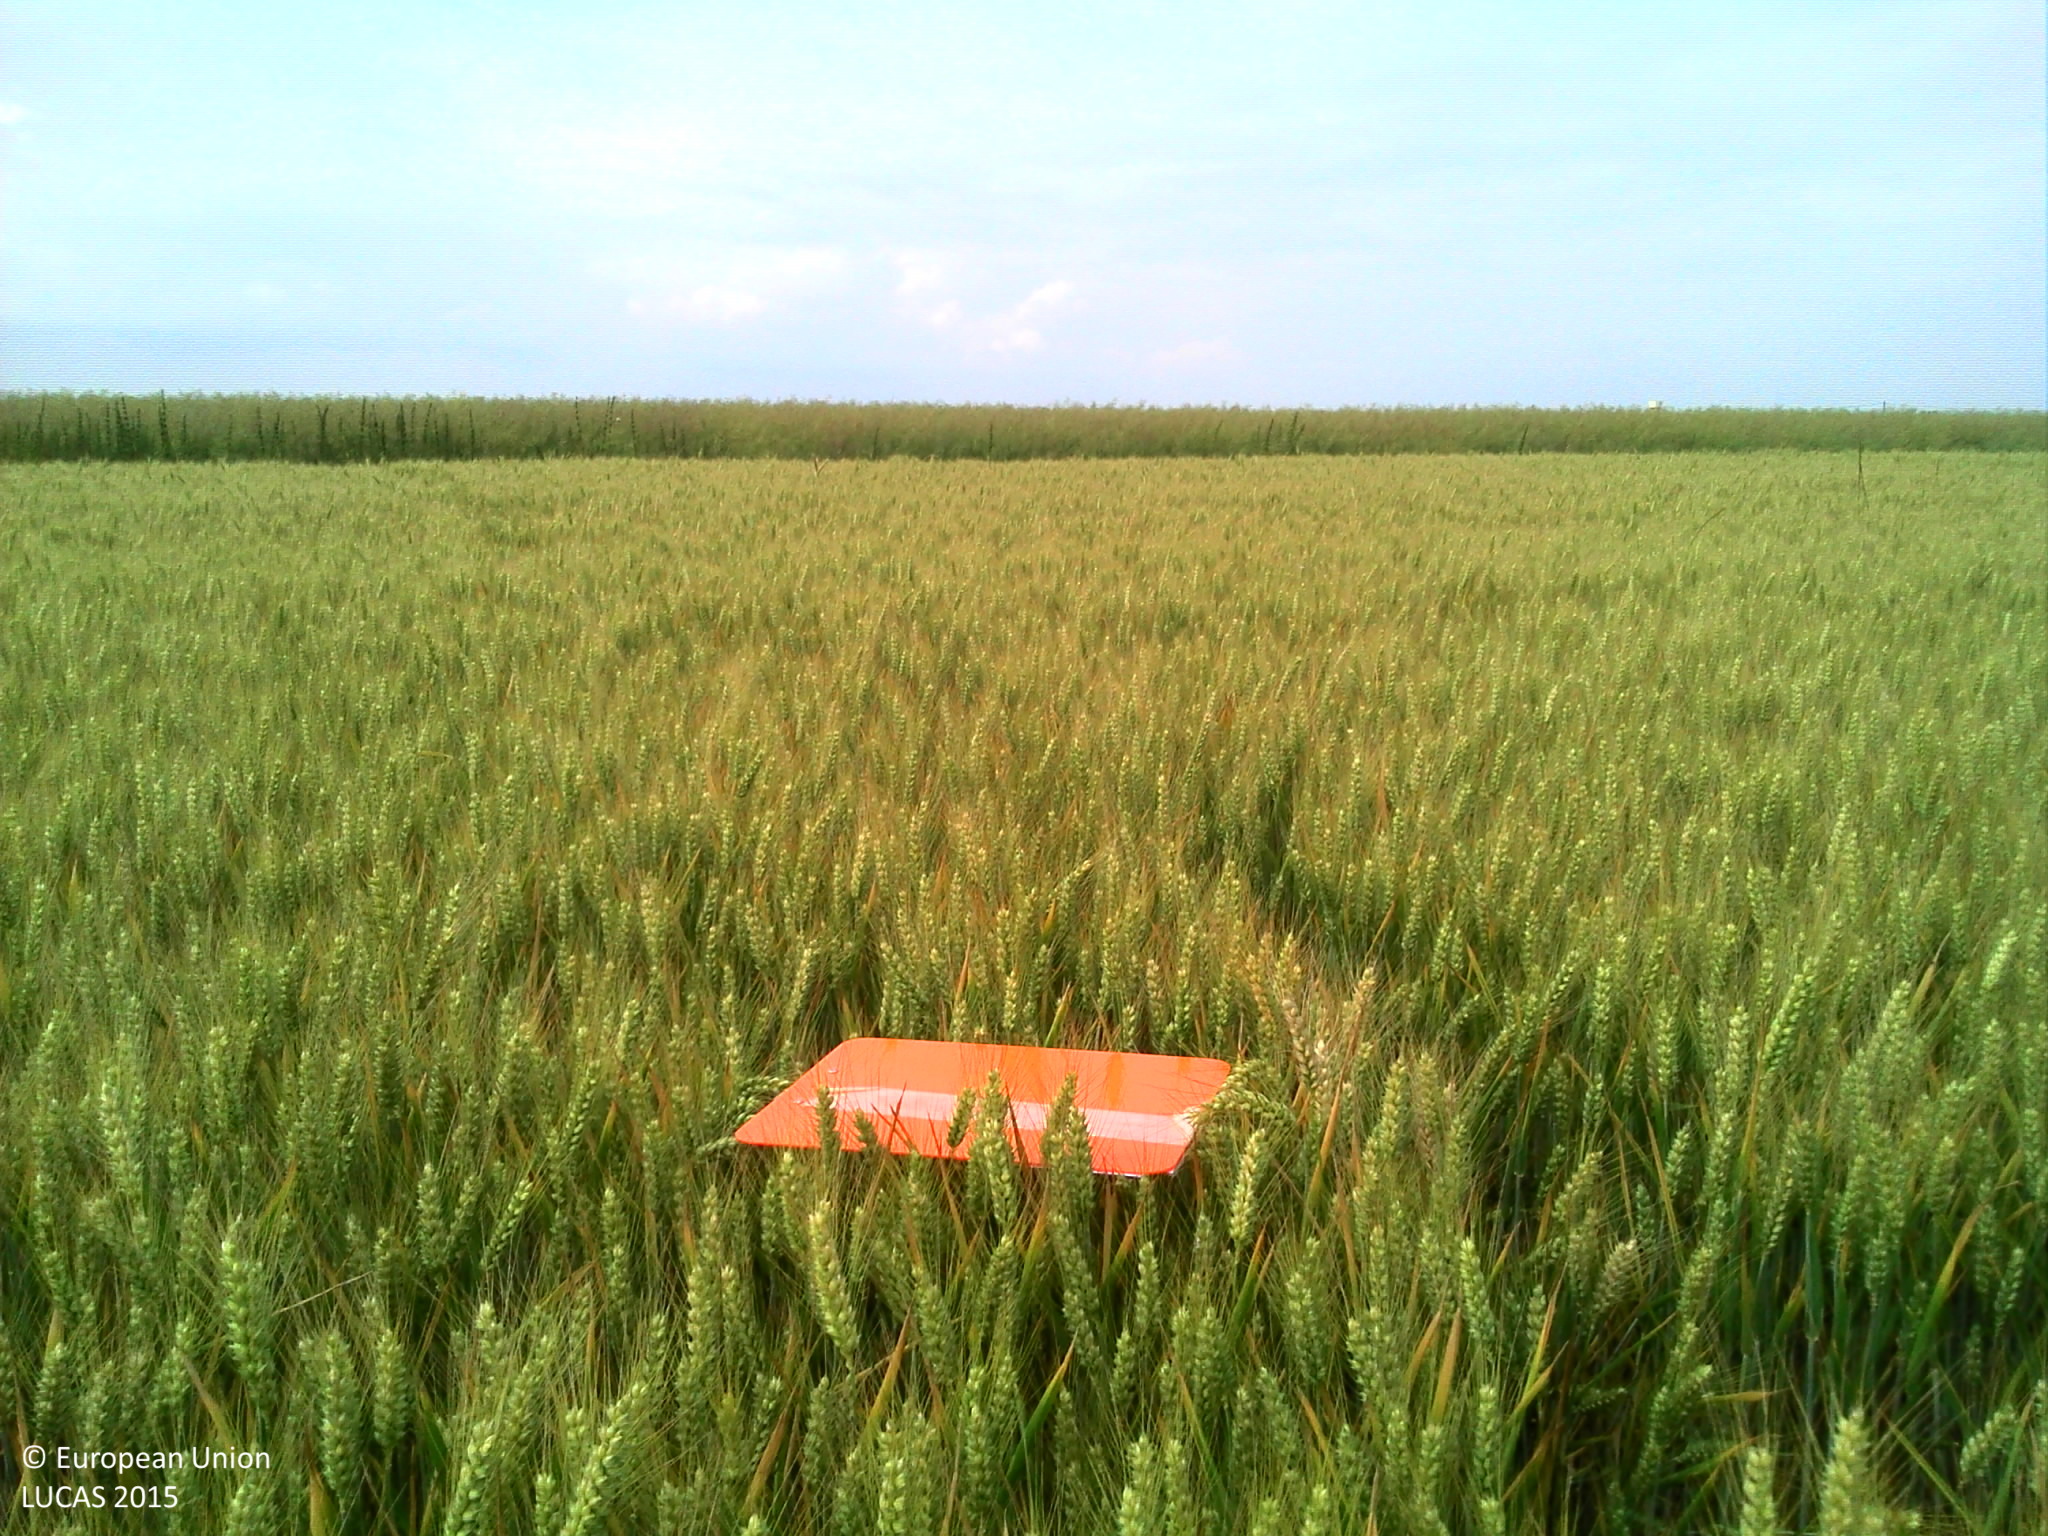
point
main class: Cropland
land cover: Common wheat
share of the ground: > 75 %
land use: Agriculture (excluding fallow land and kitchen gardens)
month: June
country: FR
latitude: 47.0237
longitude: 5.3044
